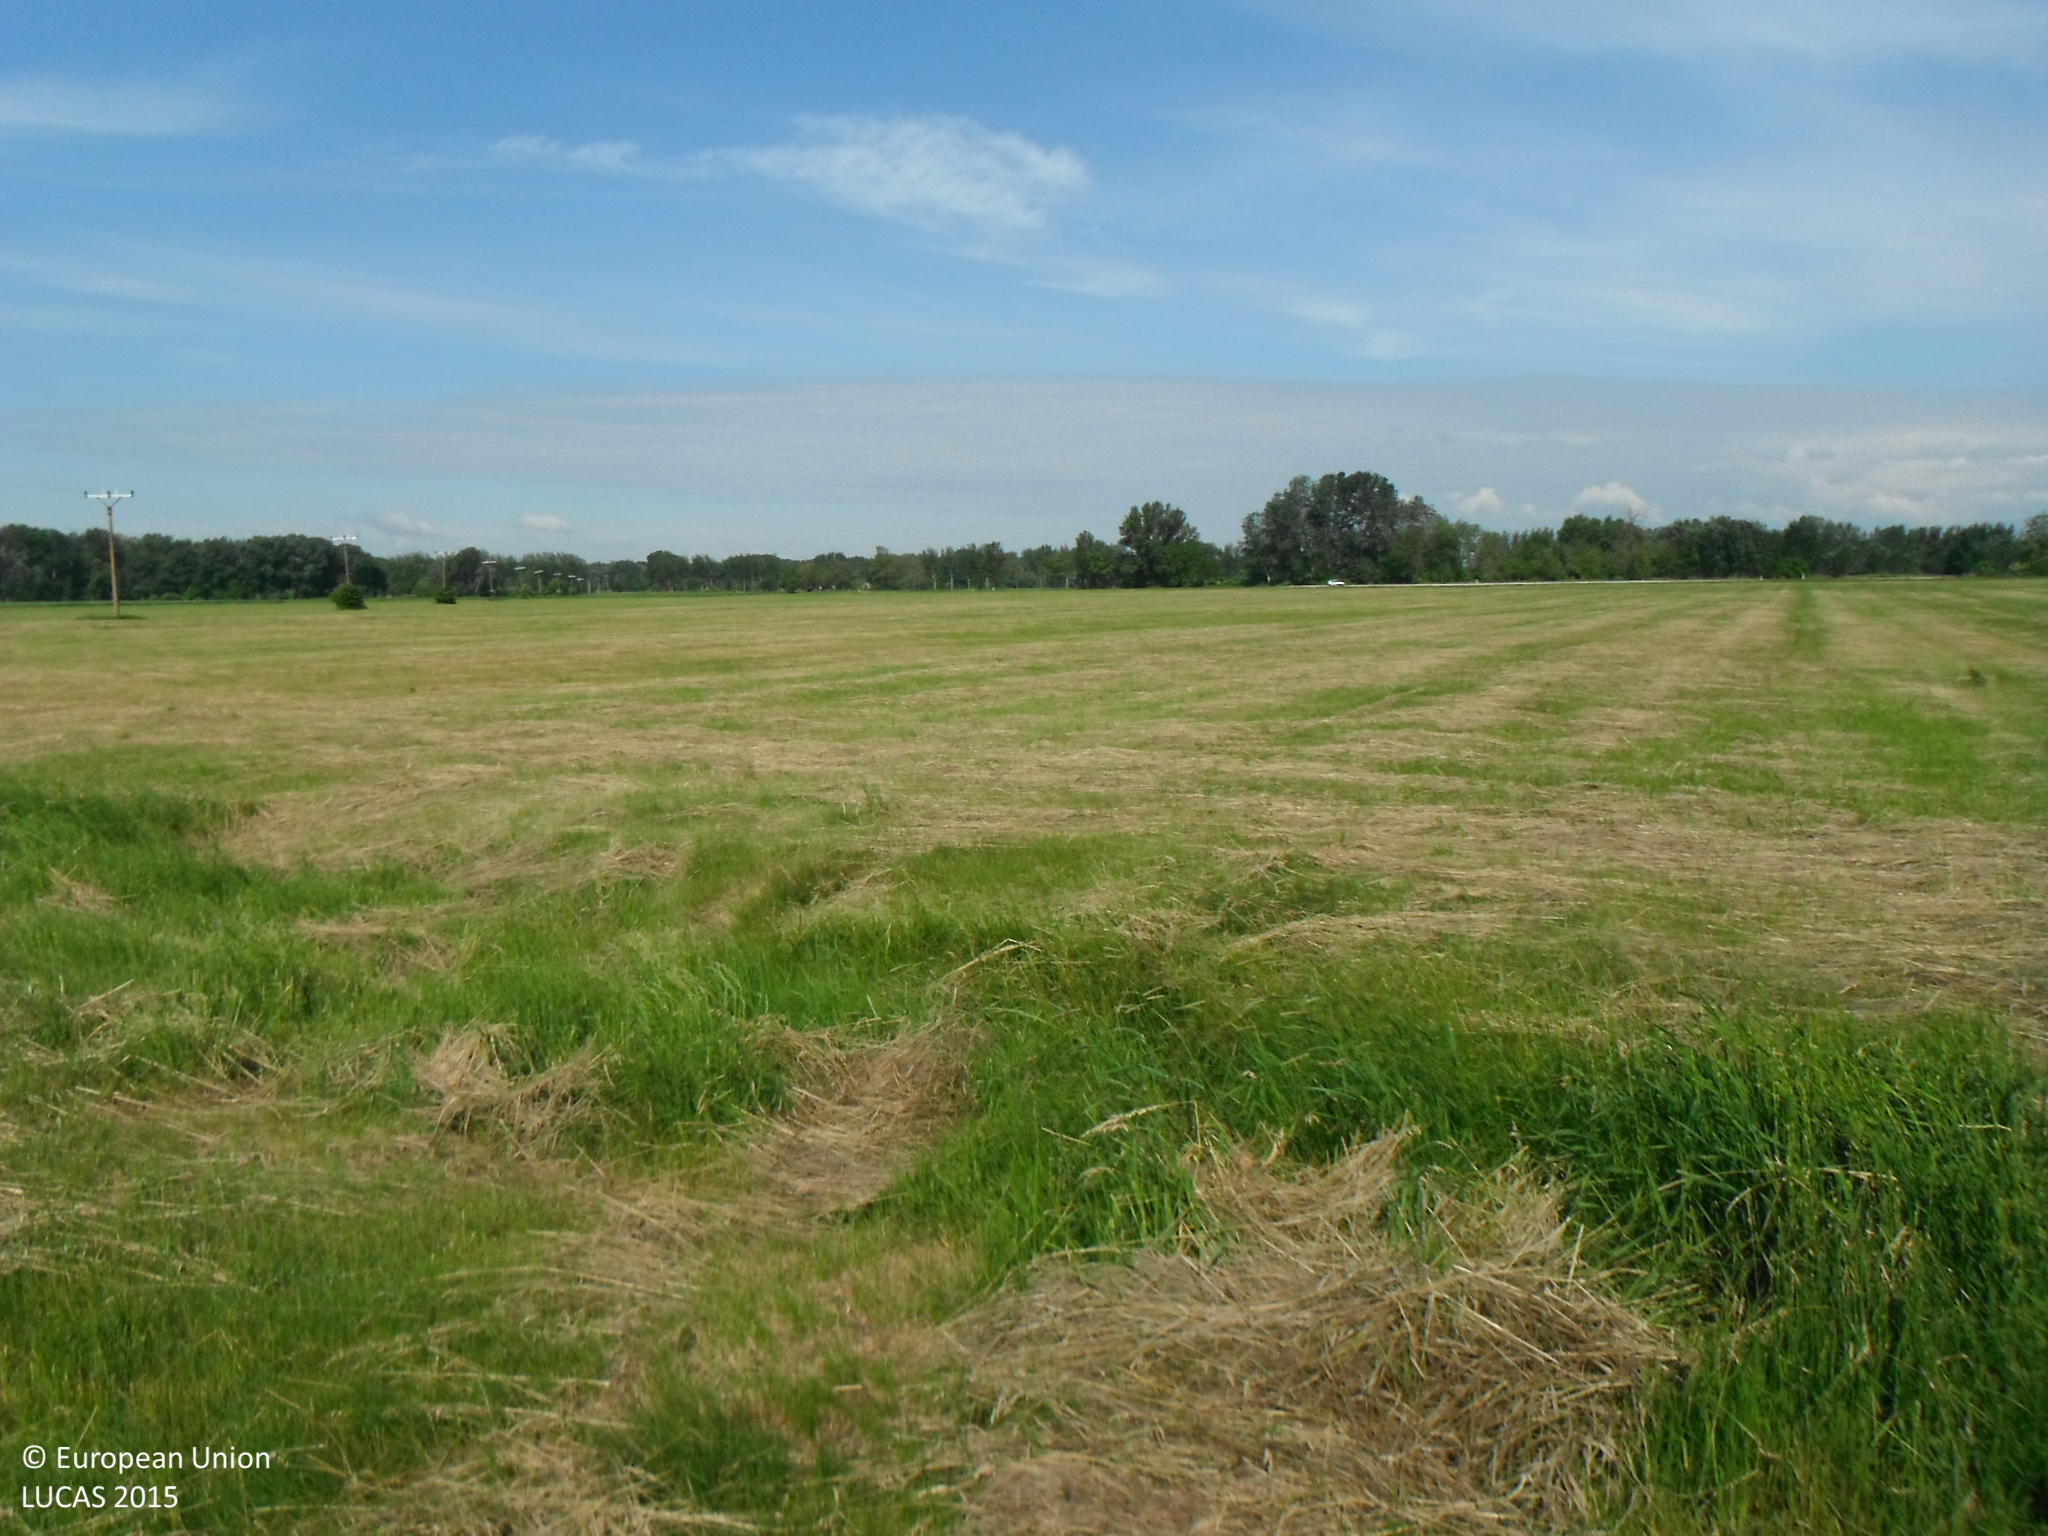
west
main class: Grassland
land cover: Grassland without tree/shrub cover
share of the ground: > 75 %
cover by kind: herbaceous plants 100 %
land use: Agriculture (excluding fallow land and kitchen gardens)
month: May
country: SK
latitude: 47.7905
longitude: 17.7123
